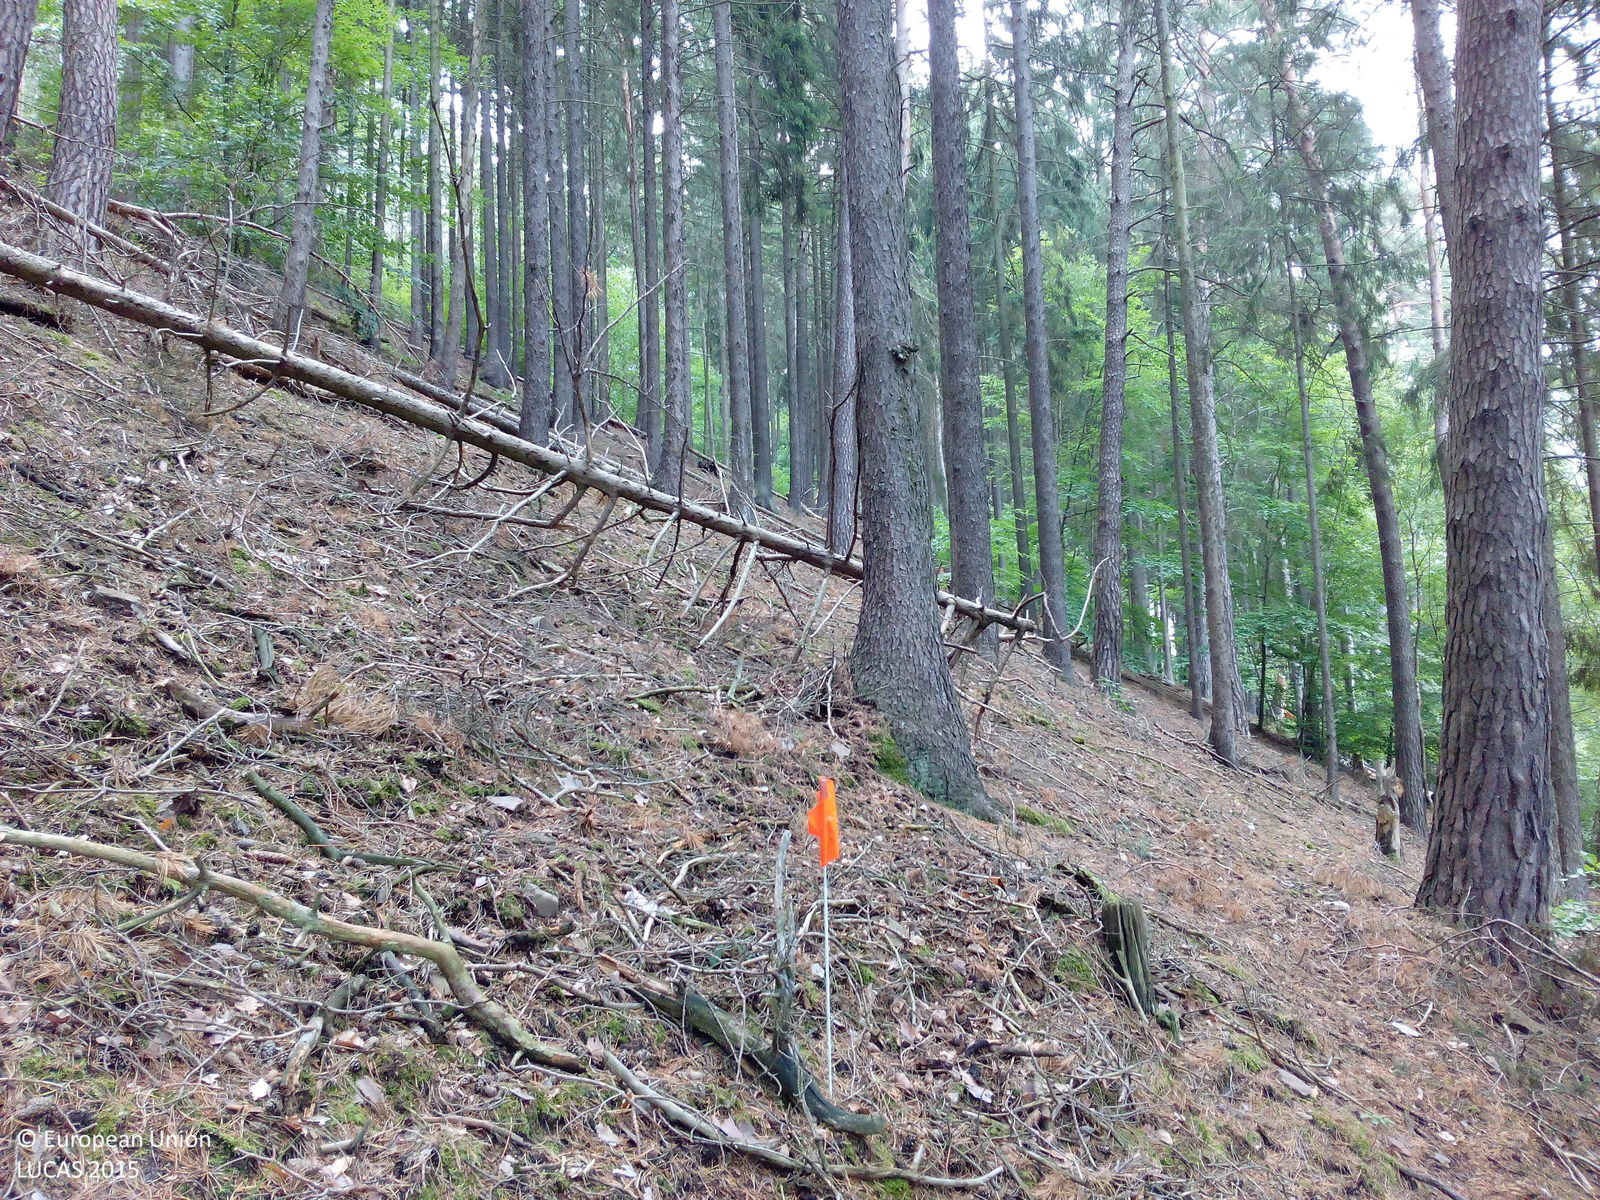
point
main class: Woodland
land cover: Pine dominated coniferous woodland
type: hemiboreal forest and nemoral coniferous forest and mixed broadleaved-coniferous forest
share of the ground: > 75 %
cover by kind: coniferous forest trees 100 %
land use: Forestry
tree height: > 5 m
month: July
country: DE
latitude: 51.6225
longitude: 9.9567
